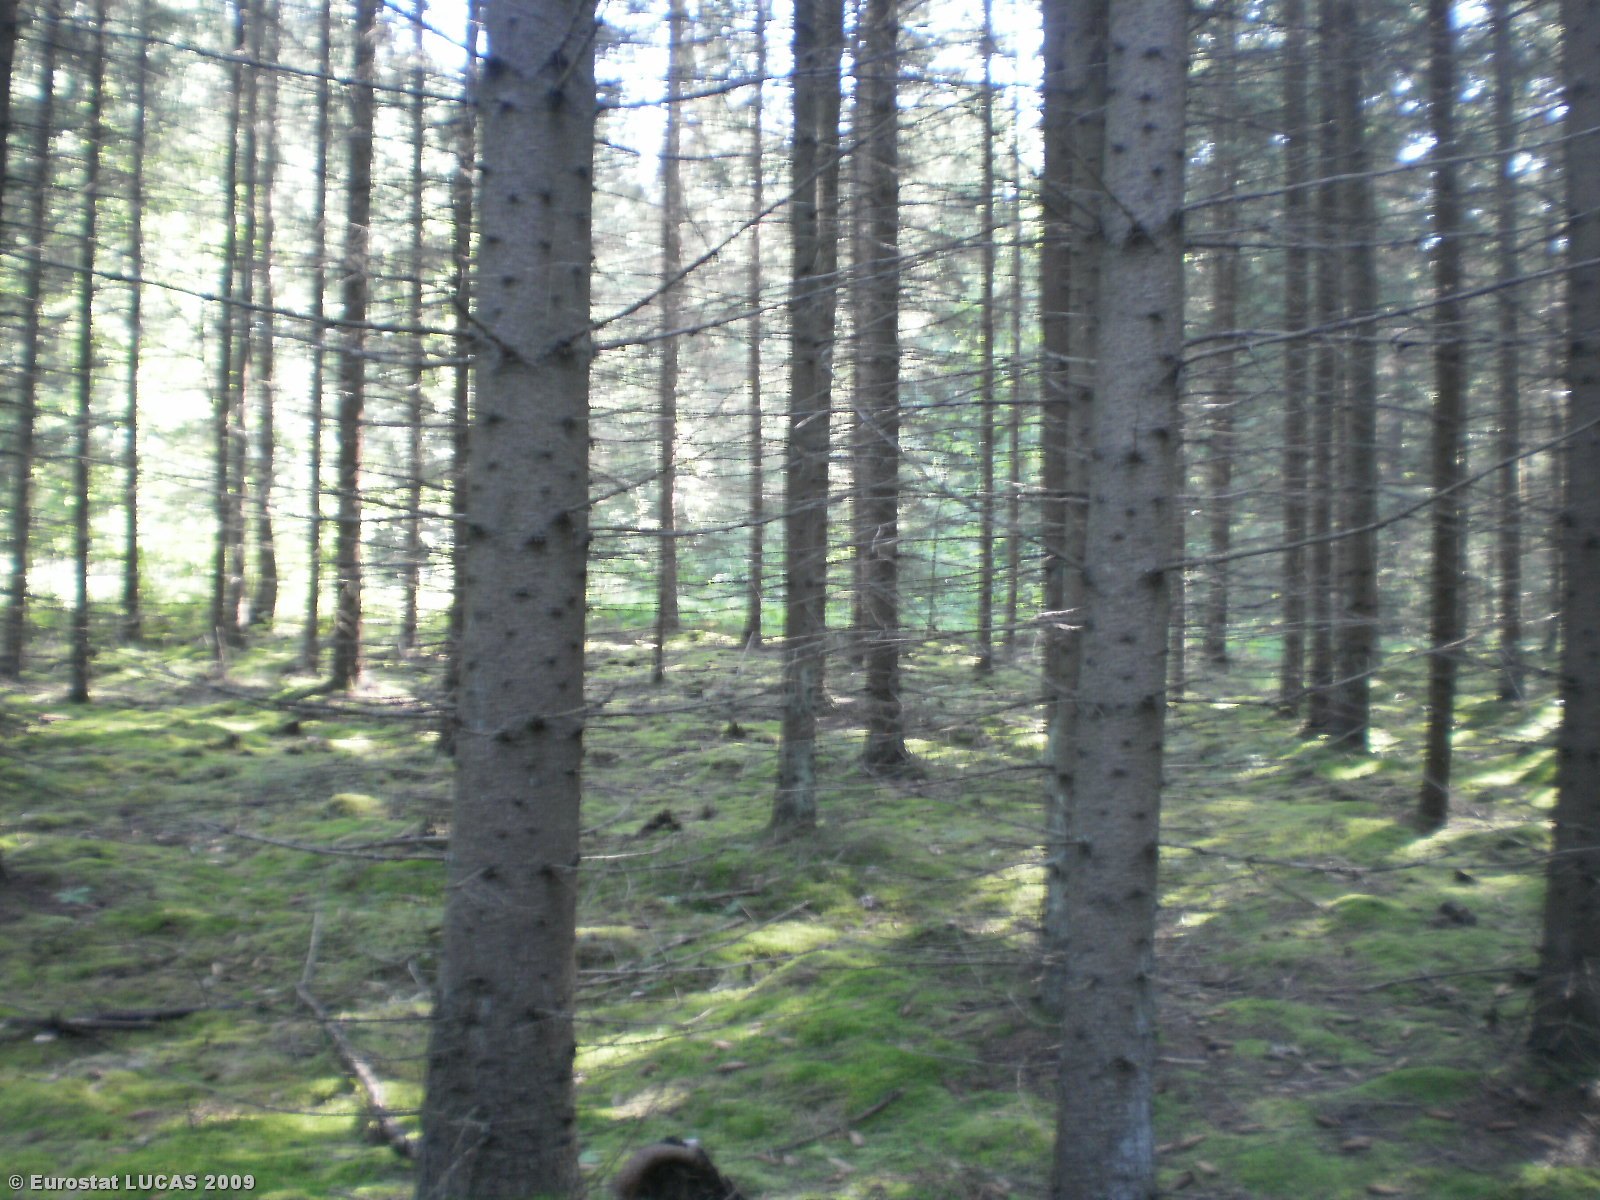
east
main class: Woodland
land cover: Coniferous woodland
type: hemiboreal forest and nemoral coniferous forest and mixed broadleaved-coniferous forest
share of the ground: > 75 %
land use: Forestry
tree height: > 5 m
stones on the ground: < 10 %
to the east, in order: Coniferous woodland; Tracks; Electric lines; Broadleaved woodland; Coniferous woodland
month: August
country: LT
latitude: 55.5667
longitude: 24.9044
